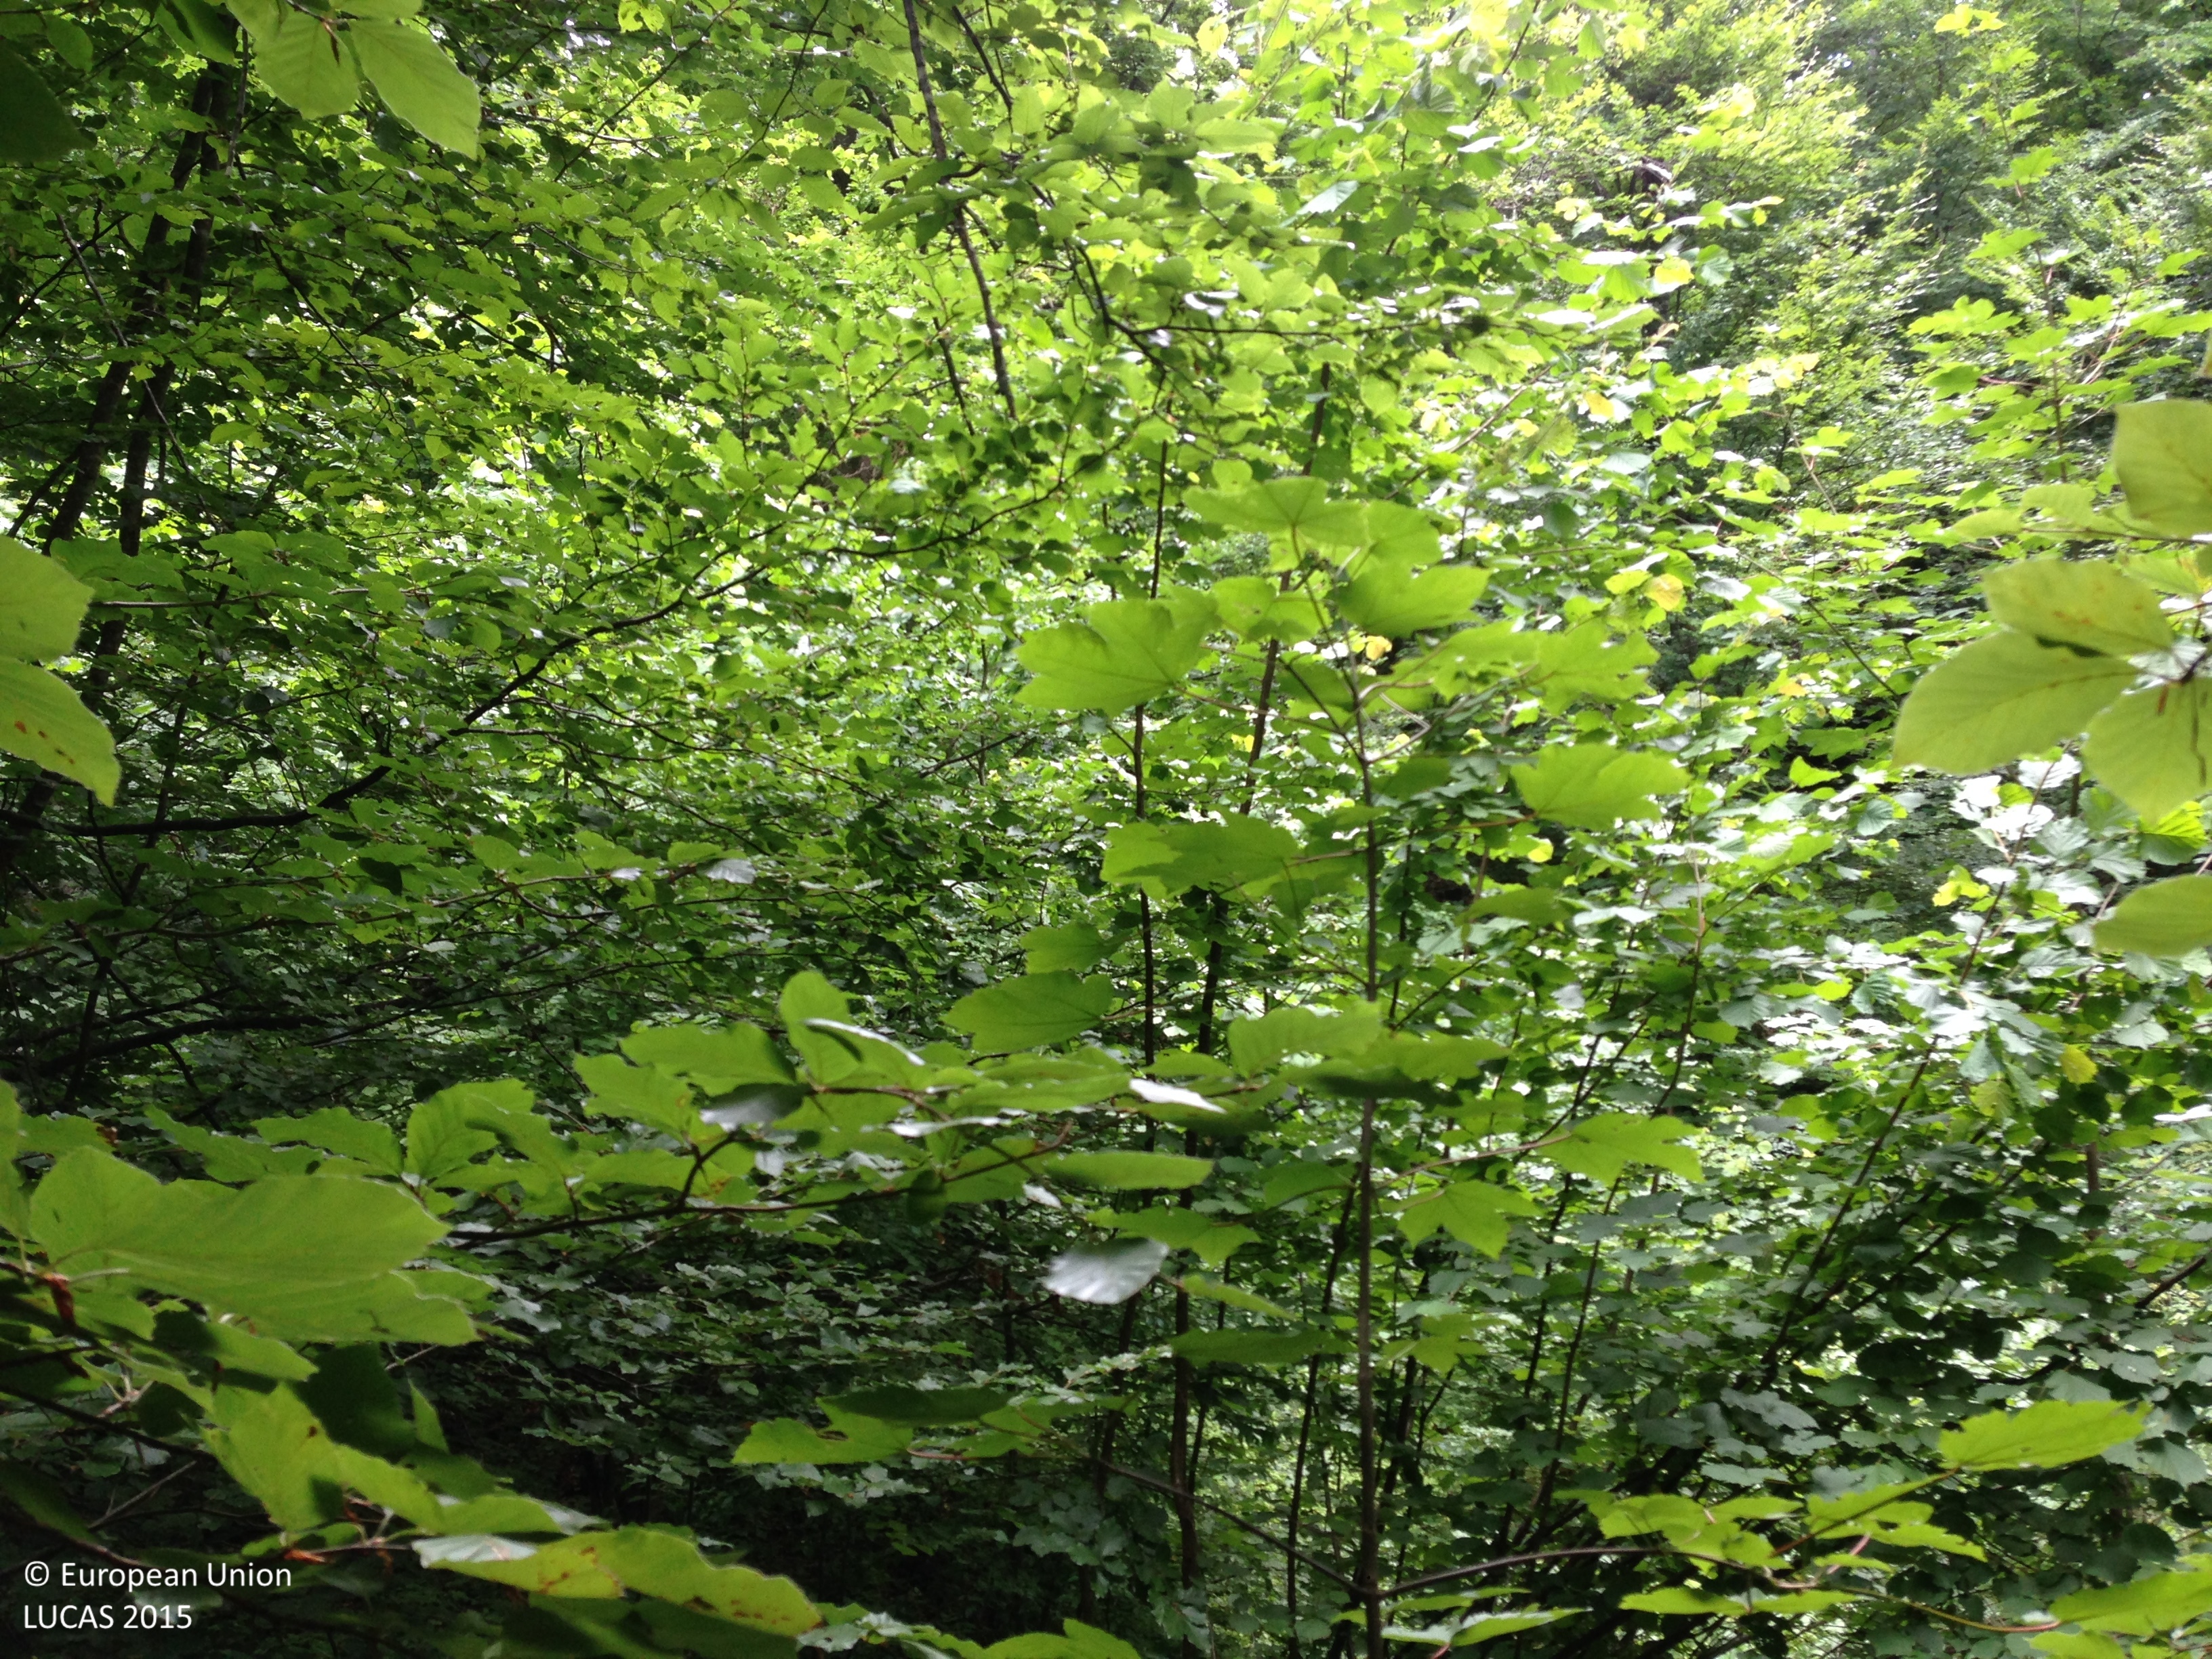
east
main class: Woodland
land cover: Broadleaved woodland
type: beech forest
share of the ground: > 75 %
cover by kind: broadleaved forest trees 60 %, herbaceous plants 15 %, shrubs 10 %, consolidated bare surface 10 %, lichens and mosses 5 %
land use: Forestry
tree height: > 5 m
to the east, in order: Broadleaved woodland
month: June
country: HR
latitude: 44.6867
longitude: 15.9372
